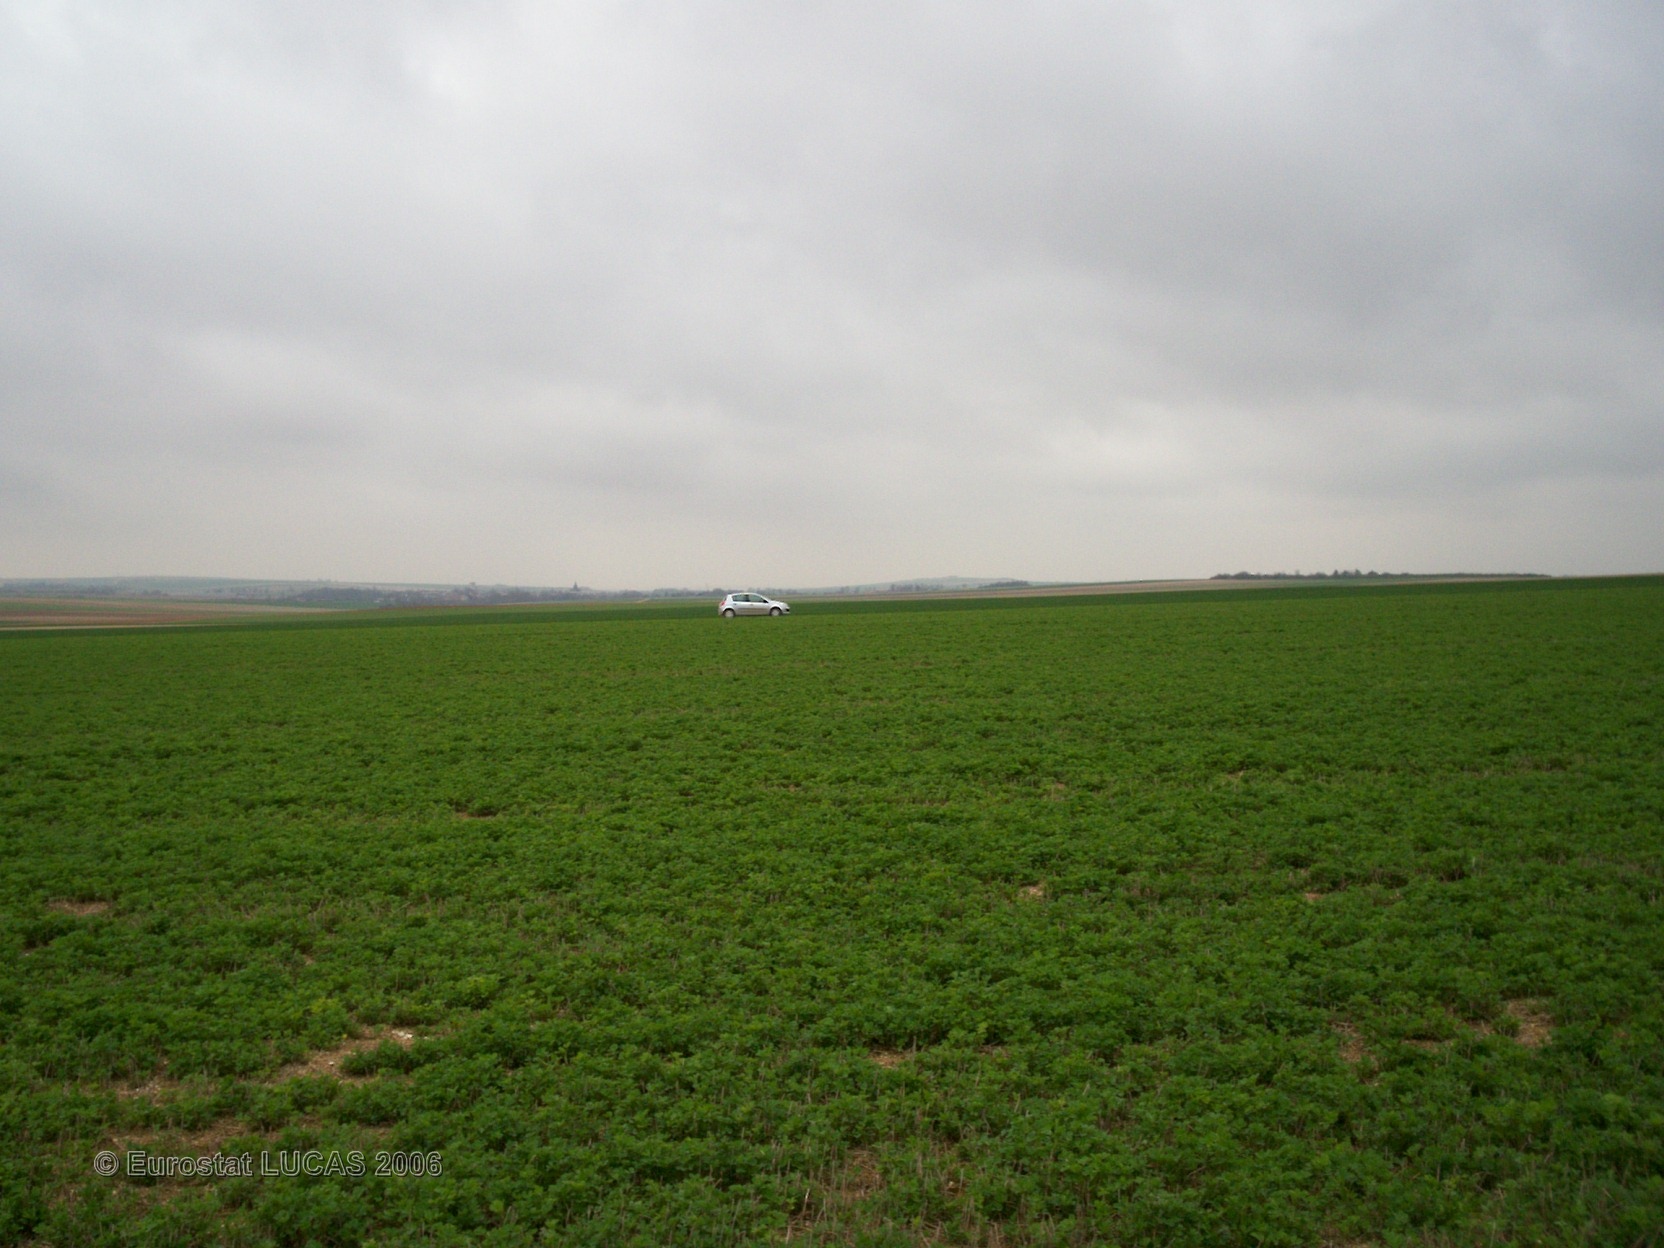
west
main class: Cropland
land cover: Lucerne
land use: Agriculture (excluding fallow land and kitchen gardens)
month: April
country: FR
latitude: 49.2630
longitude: 4.5963
